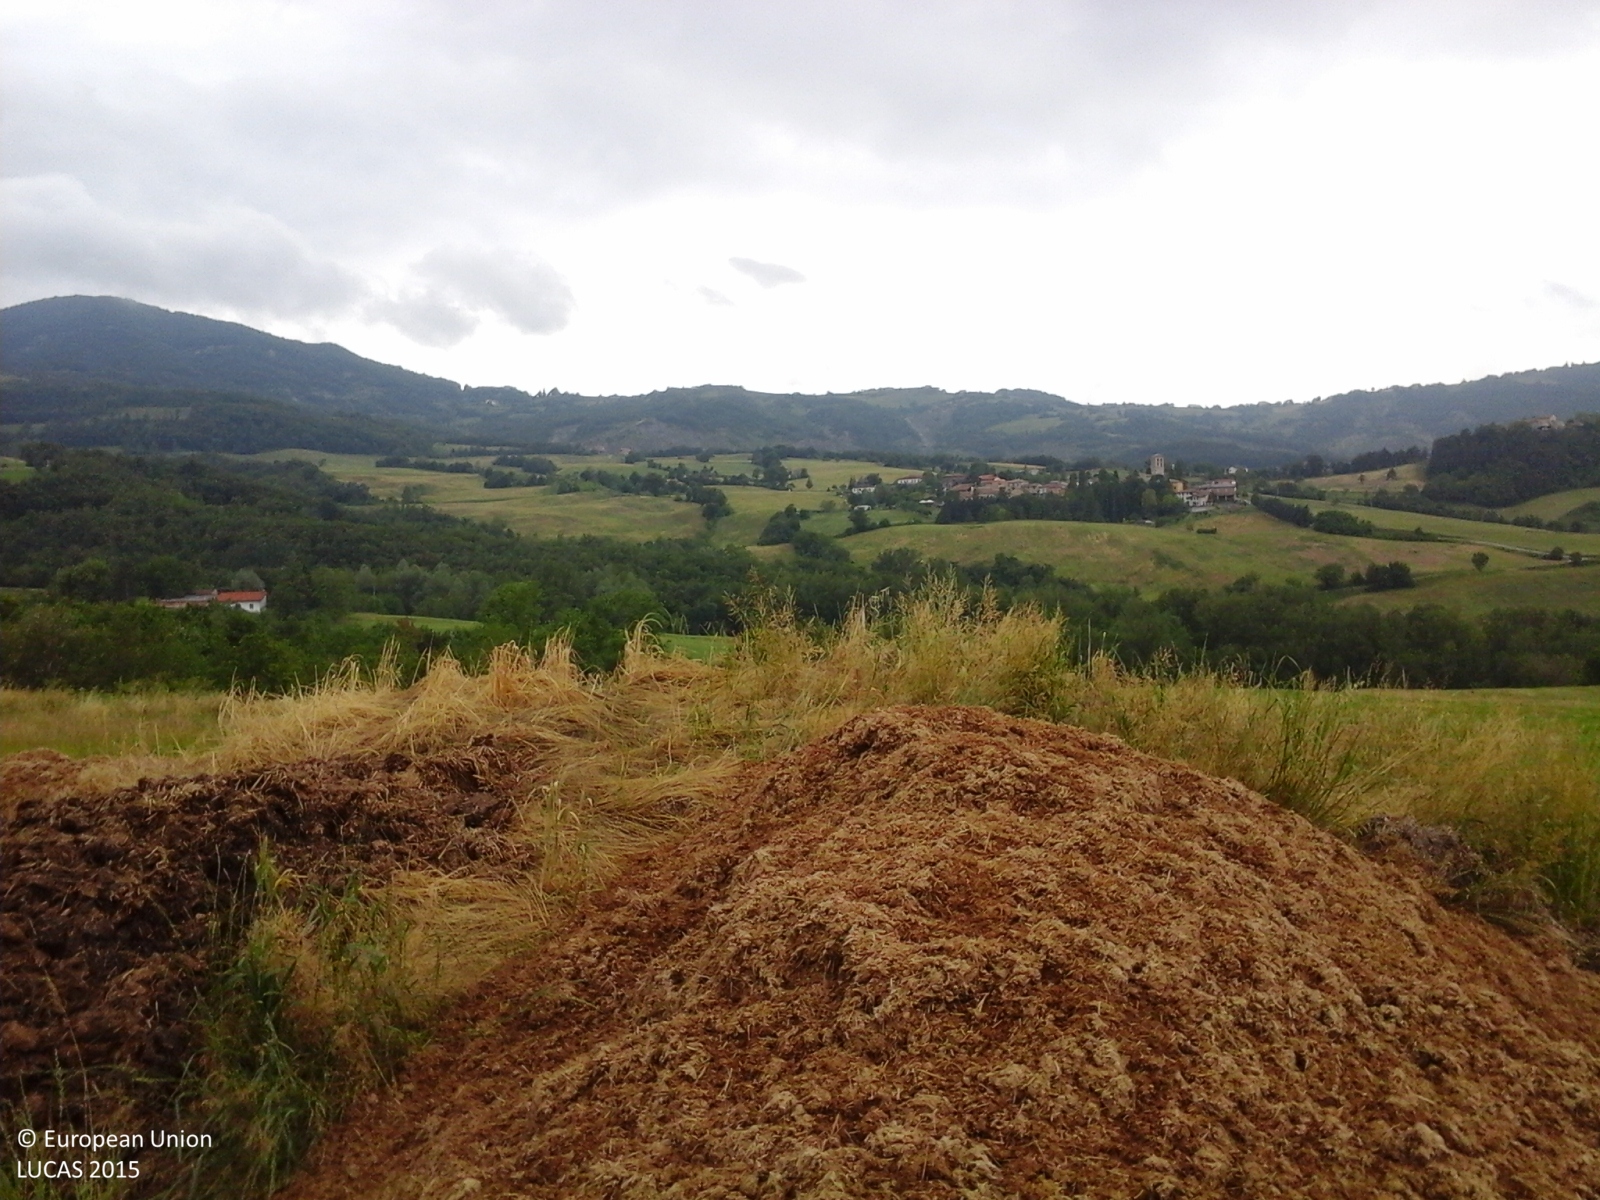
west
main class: Grassland
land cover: Grassland without tree/shrub cover
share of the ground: > 75 %
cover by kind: herbaceous plants 100 %
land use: Agriculture (excluding fallow land and kitchen gardens)
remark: Harvested field
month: May
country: IT
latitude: 44.6210
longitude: 10.1132
